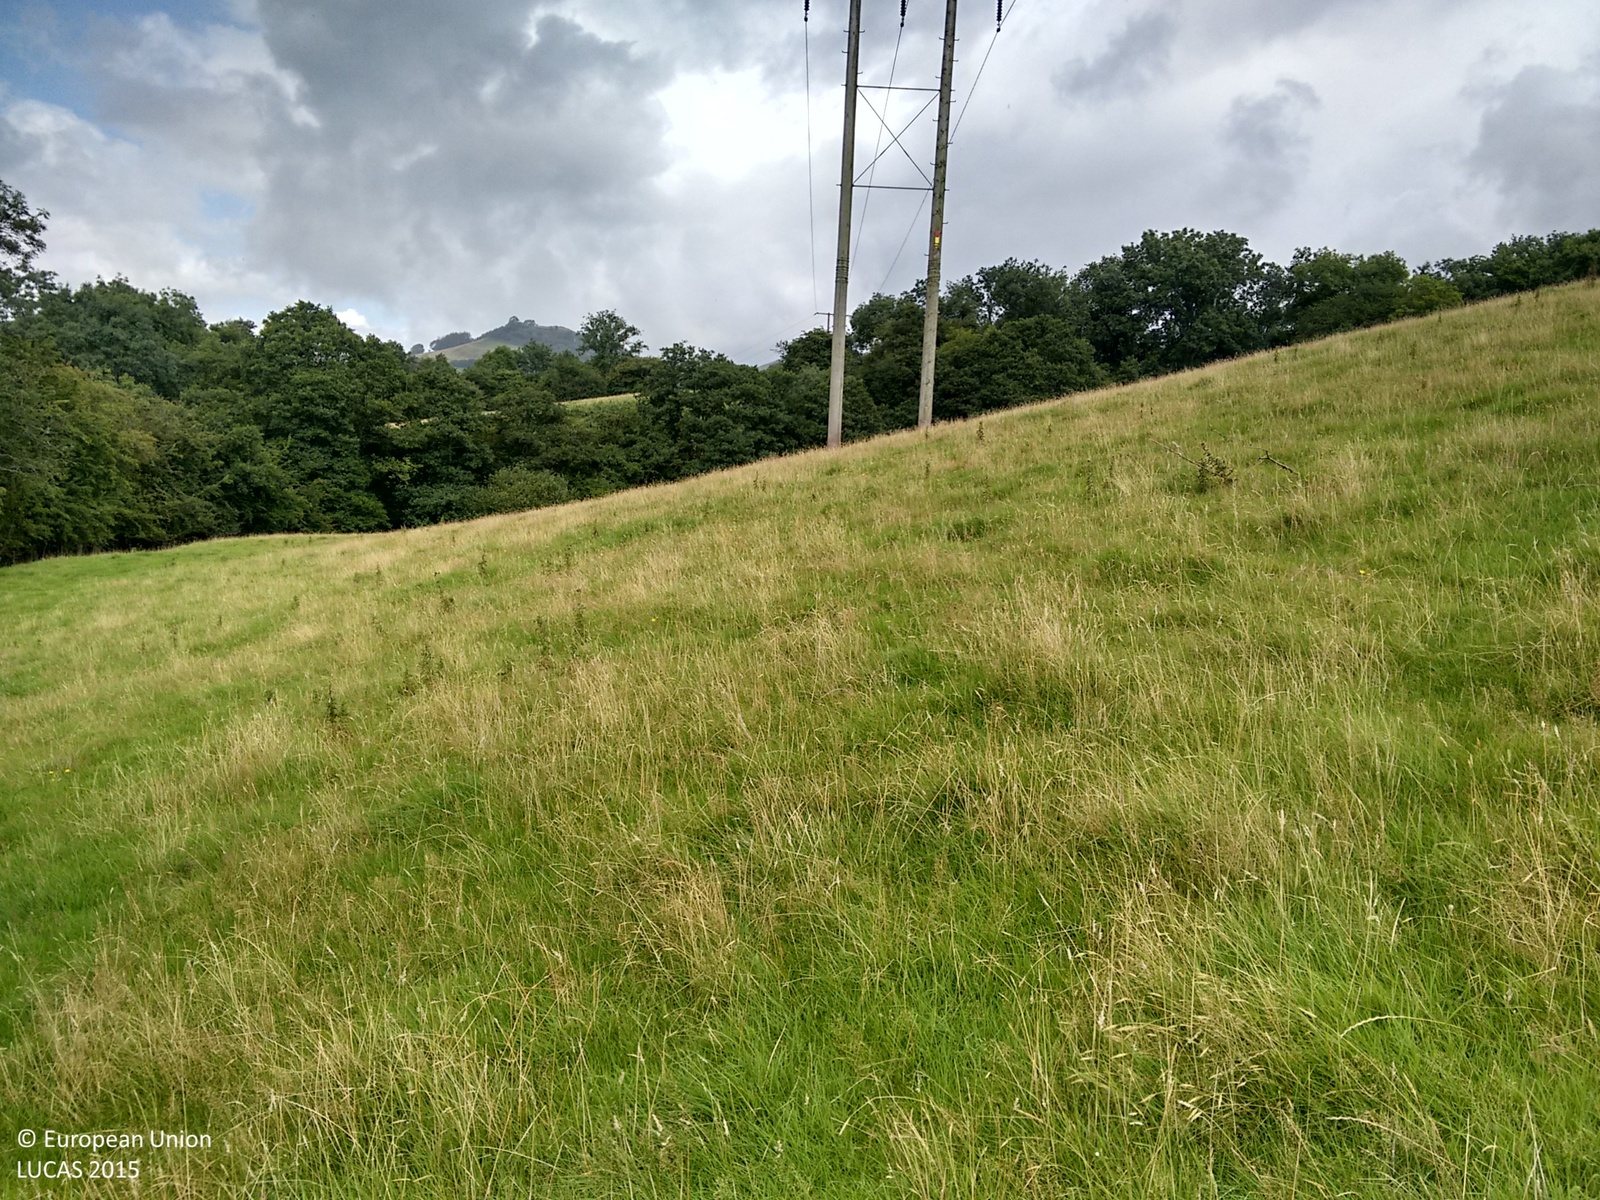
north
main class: Grassland
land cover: Grassland without tree/shrub cover
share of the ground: > 75 %
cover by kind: herbaceous plants 100 %
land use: Agriculture (excluding fallow land and kitchen gardens)
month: September
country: GB
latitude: 51.9475
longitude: -3.1870
